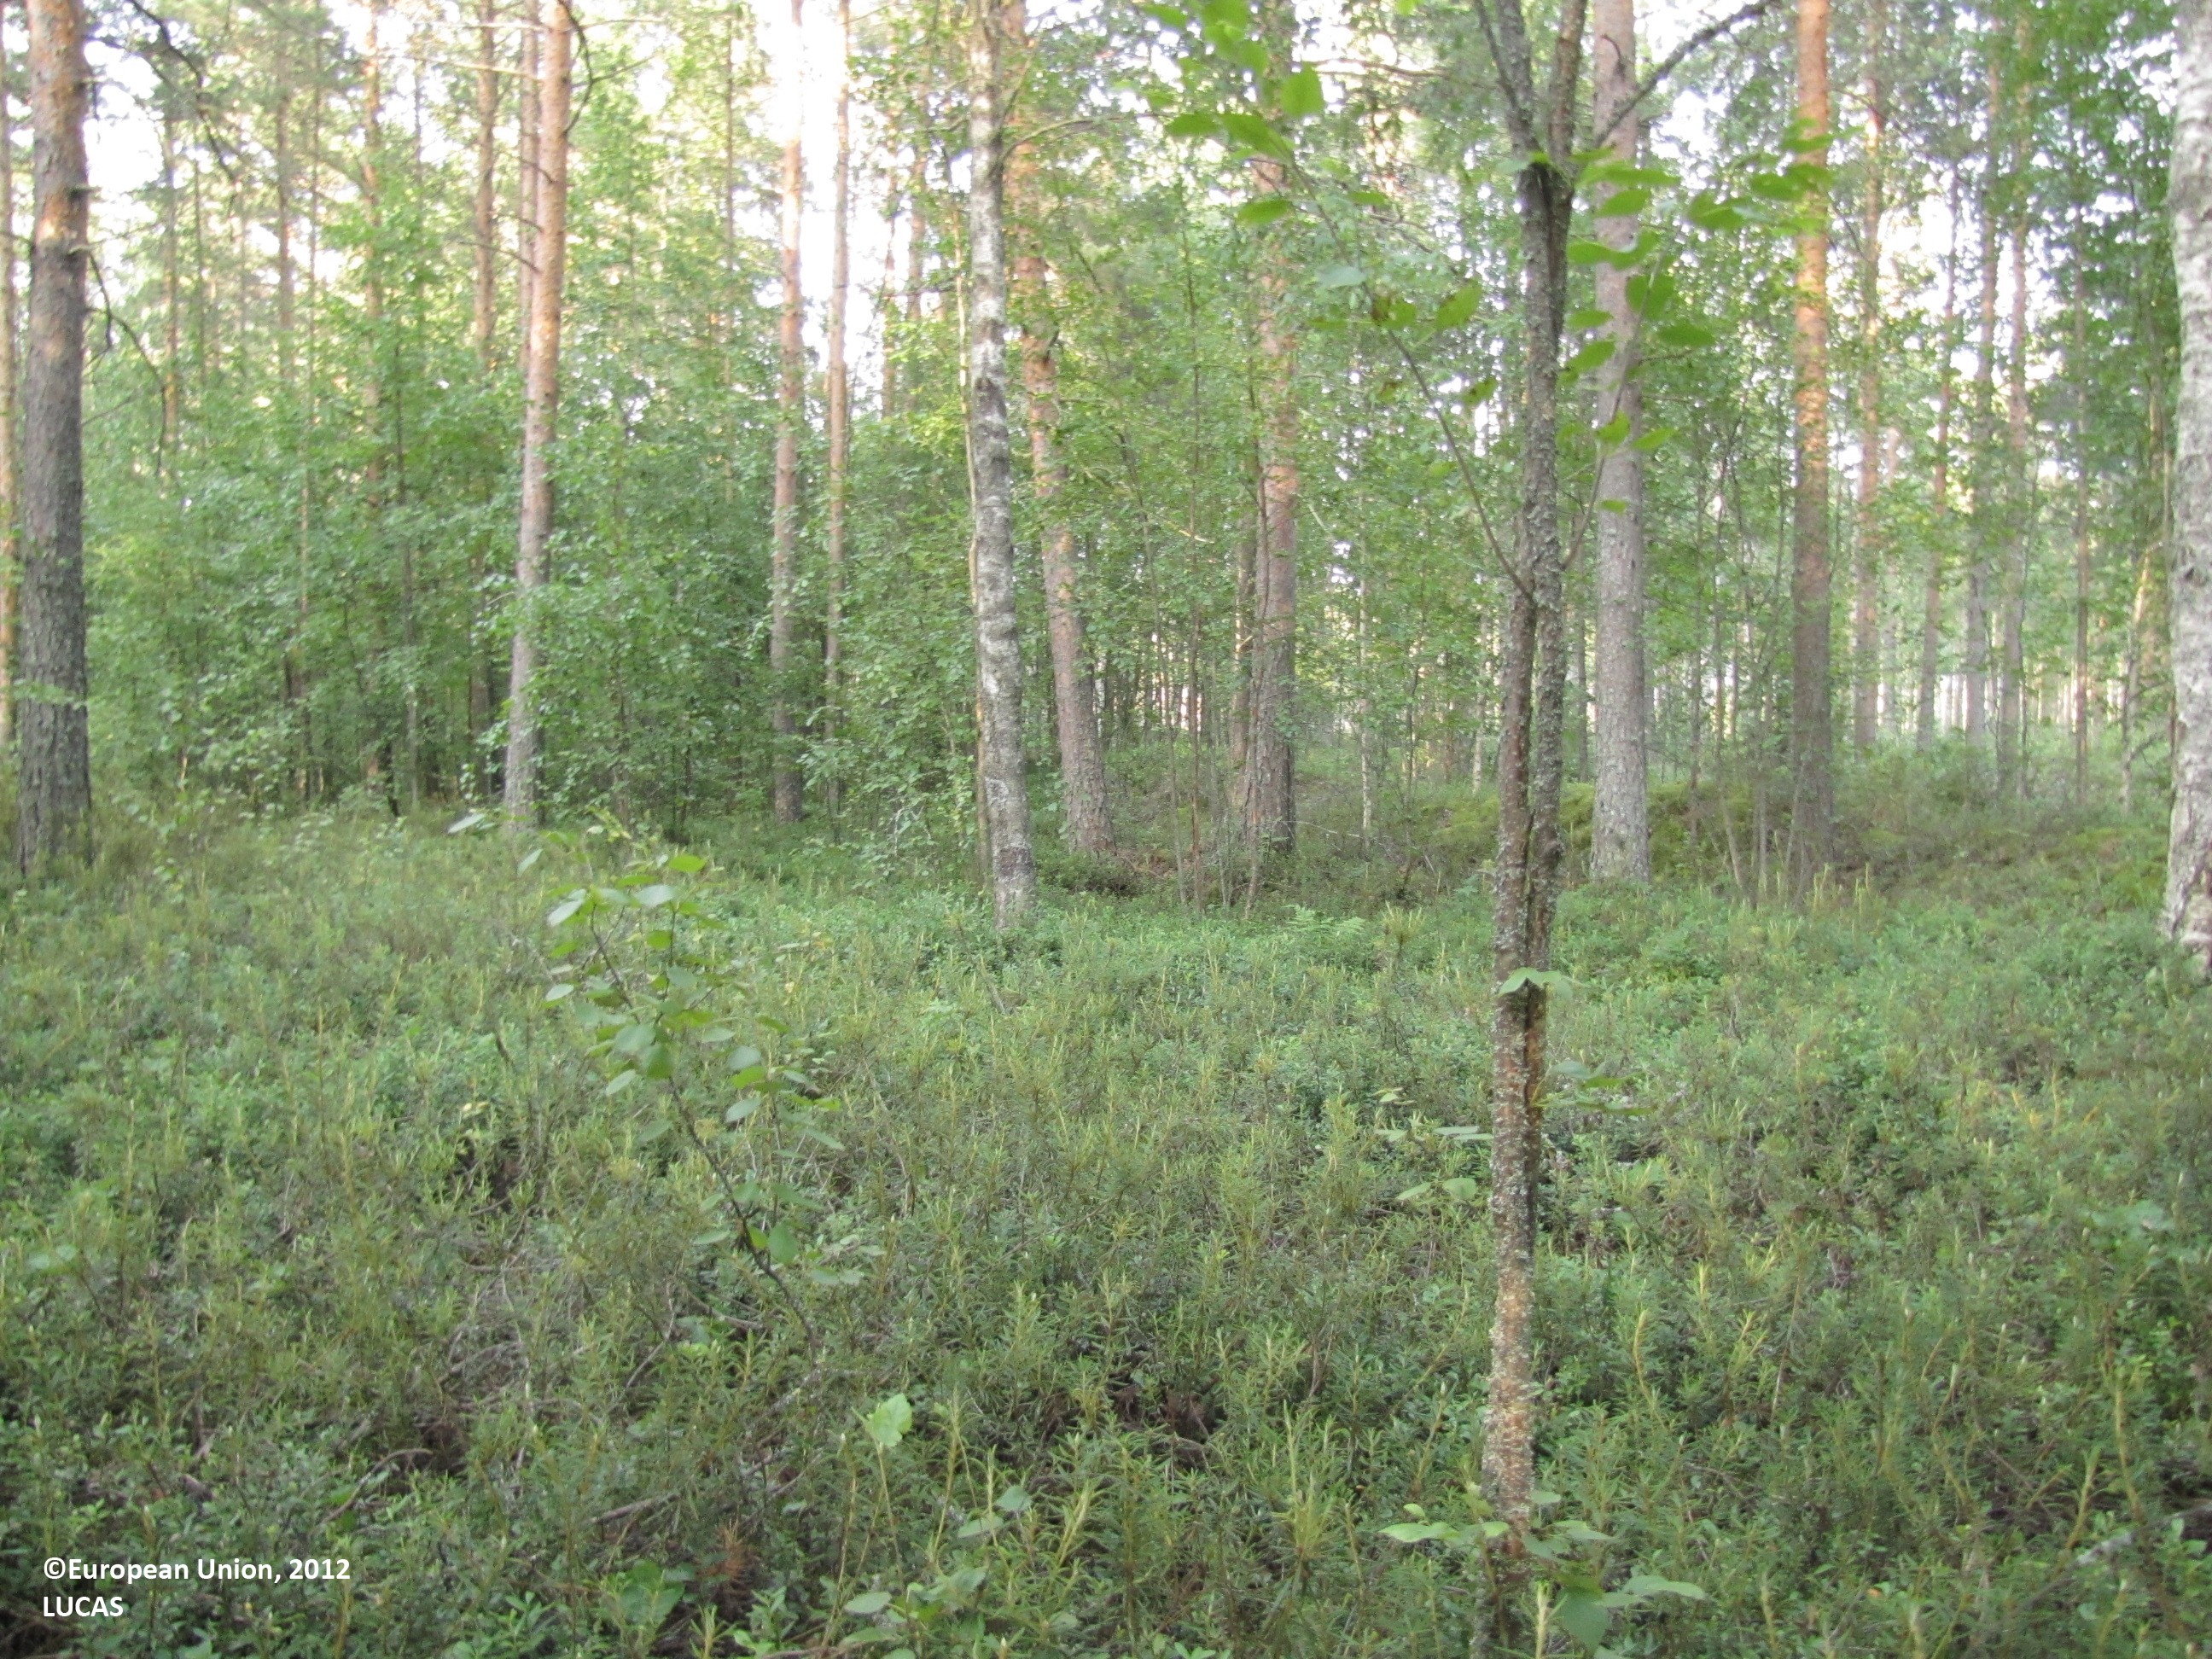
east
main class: Woodland
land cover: Pine dominated mixed woodland
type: mire and swamp forests
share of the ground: > 75 %
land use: Forestry
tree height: > 5 m
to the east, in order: Pine dominated mixed woodland; Ditches and canals; Pine dominated mixed woodland; Ditches and canals; Pine dominated mixed woodland; Abandoned hedges; Ditches and canals; Grass margins; Barley
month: July
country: FI
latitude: 62.5925
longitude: 23.4473
